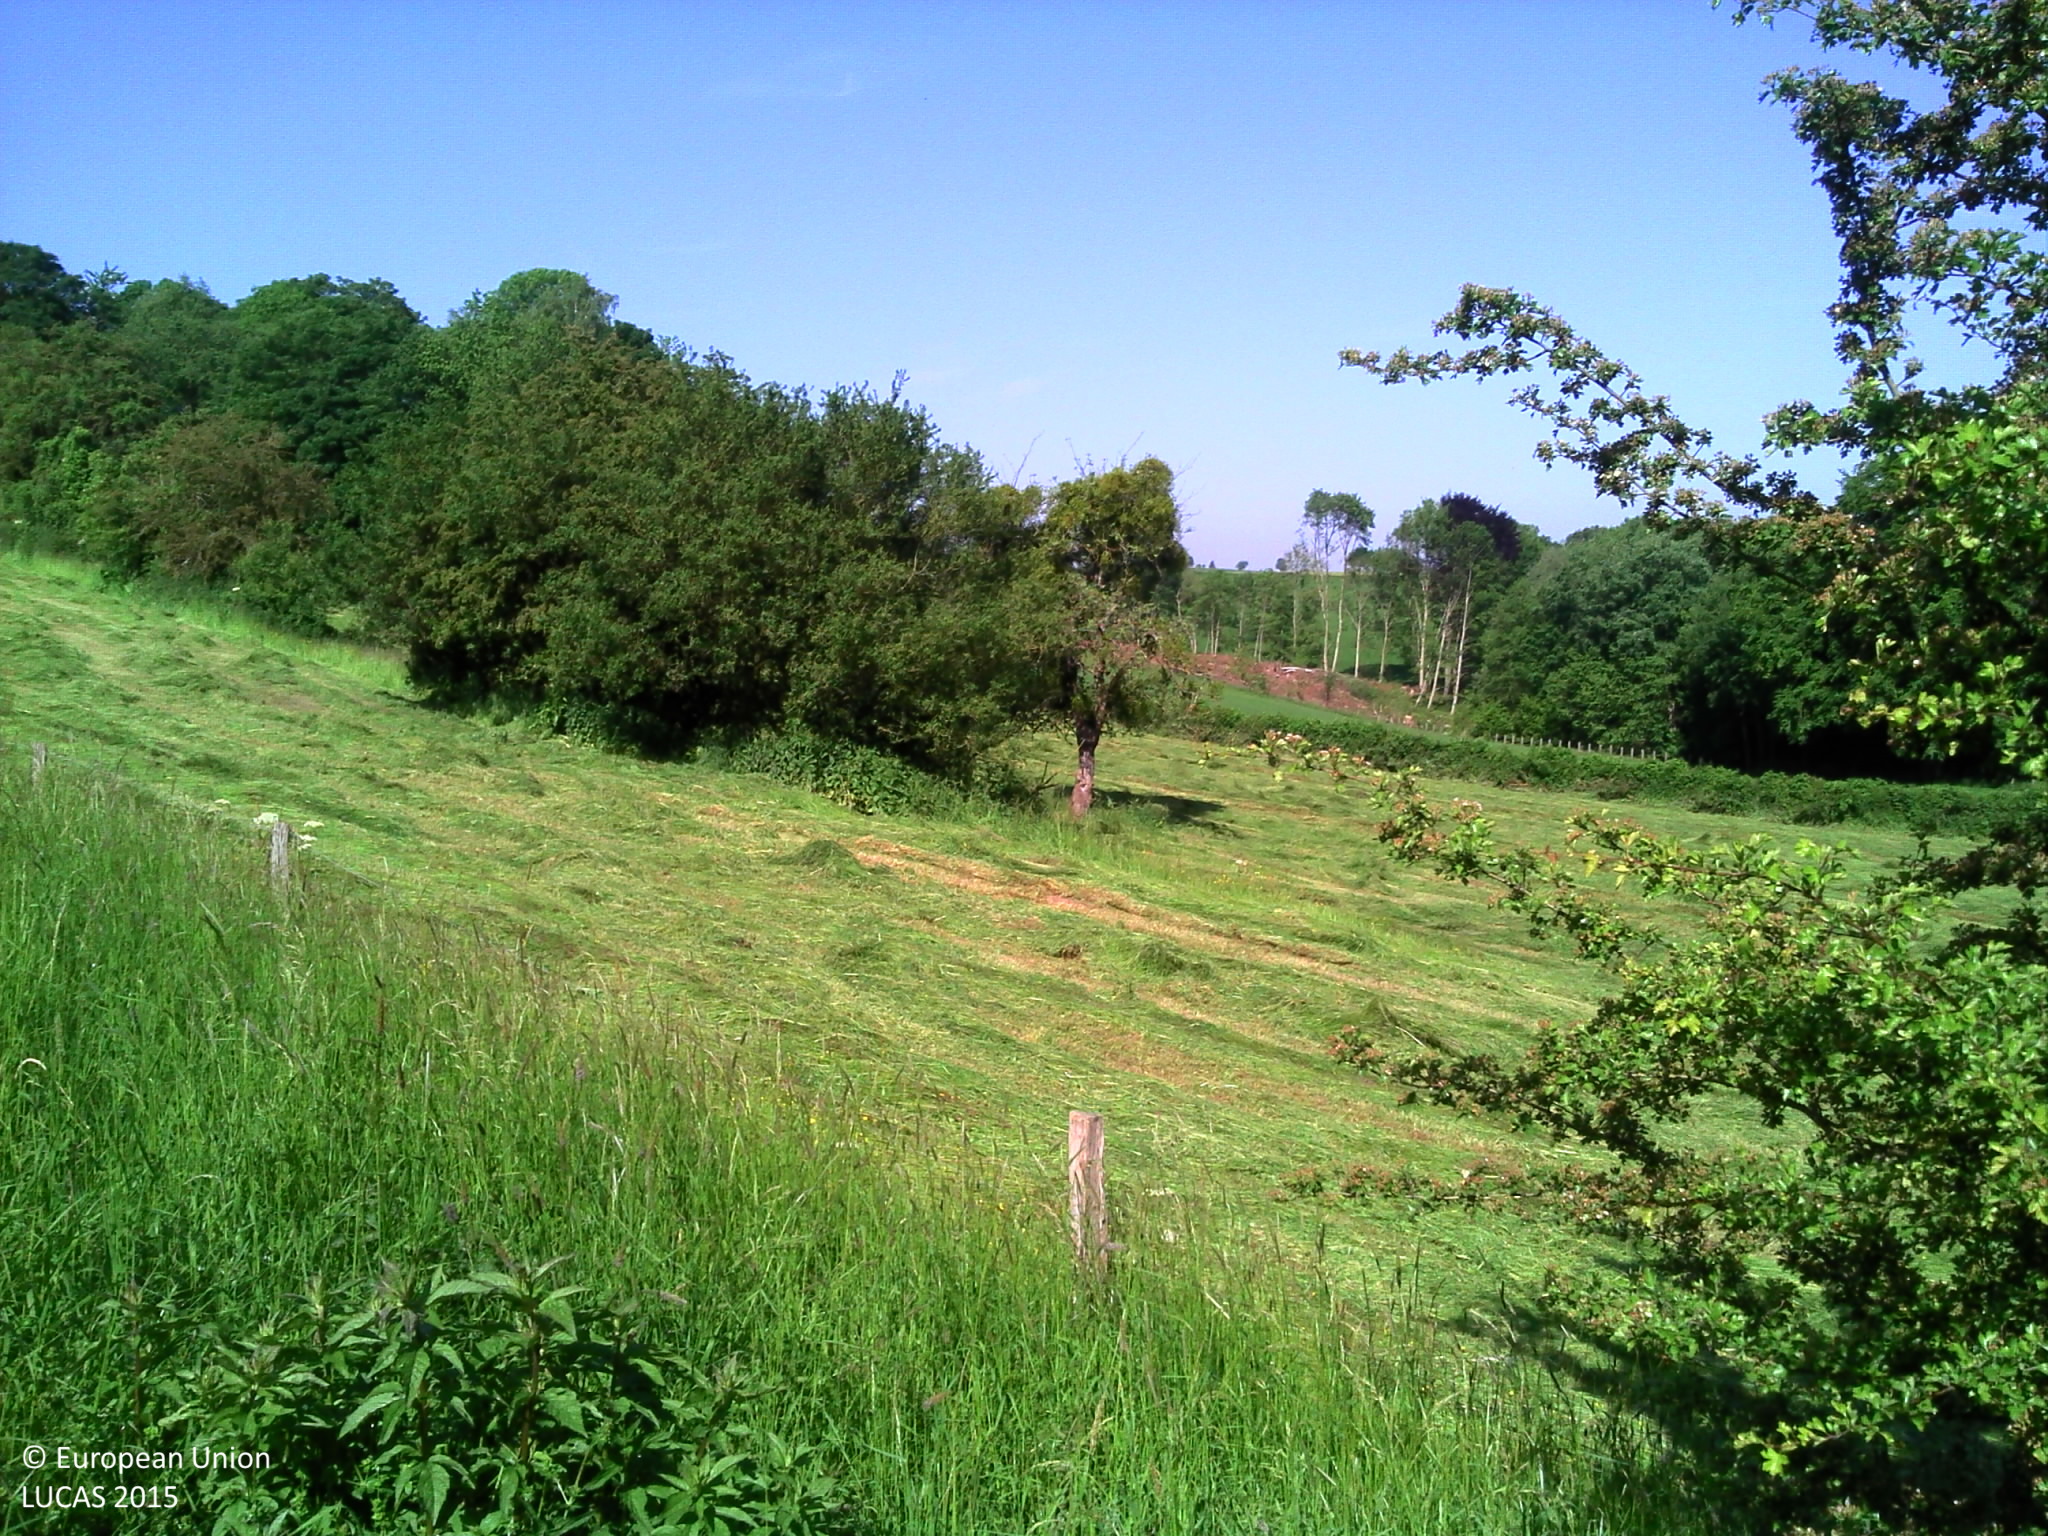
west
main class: Grassland
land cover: Spontaneously vegetated surfaces
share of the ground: > 75 %
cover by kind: herbaceous plants 100 %
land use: Semi-natural and natural areas not in use
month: June
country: BE
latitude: 50.5172
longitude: 5.6970
